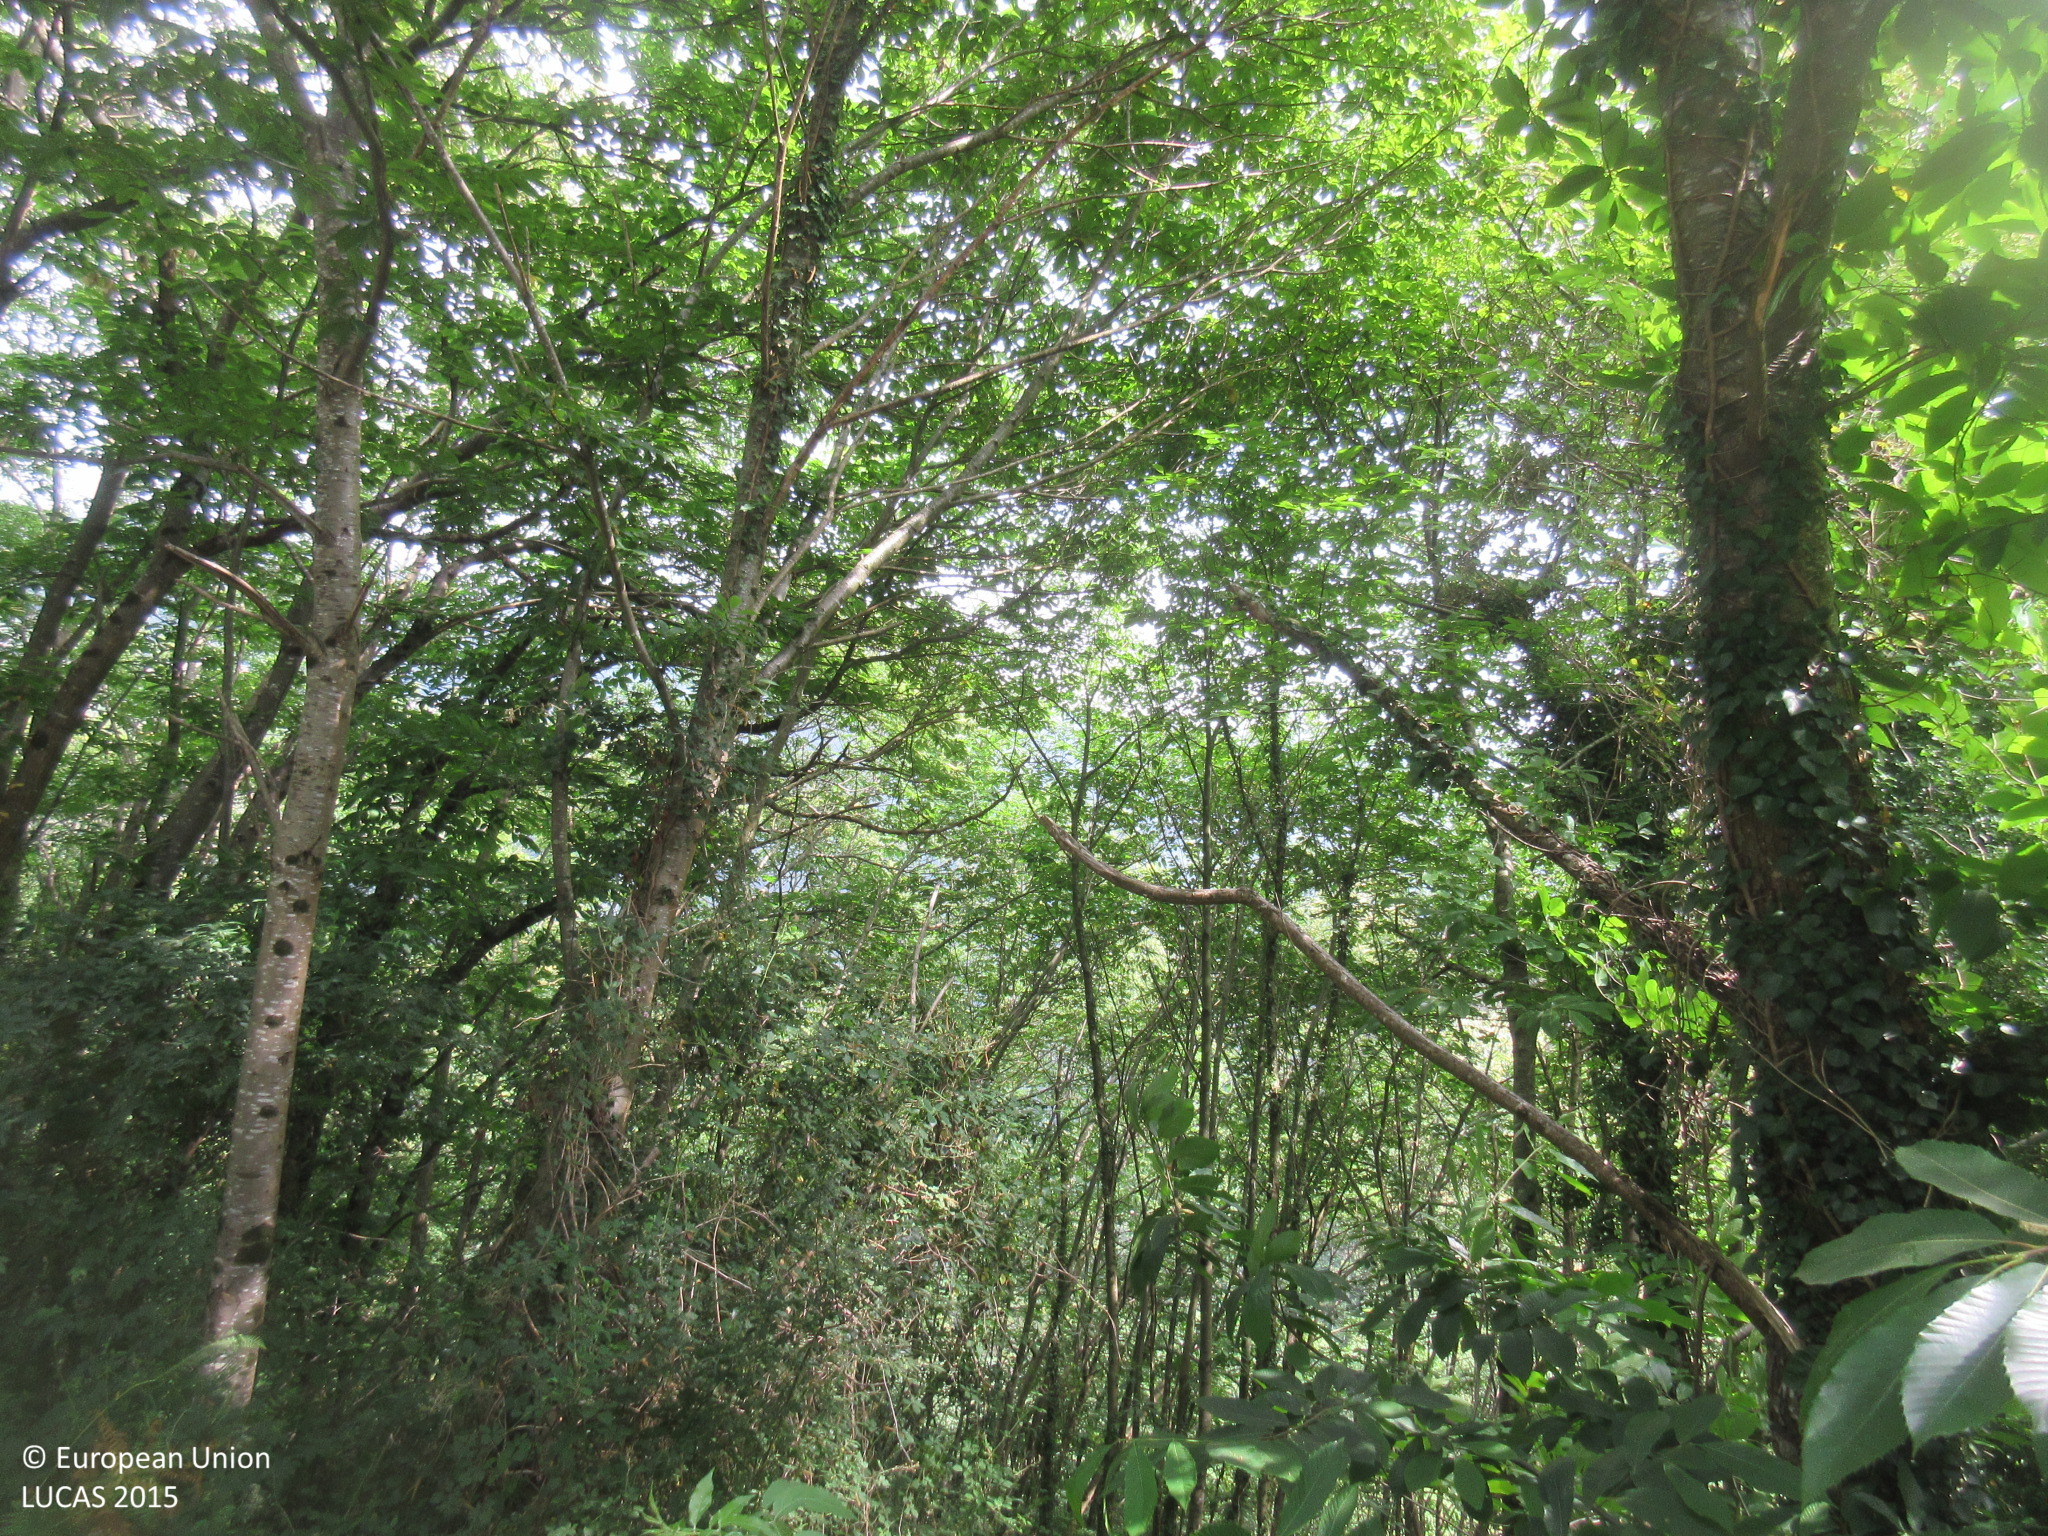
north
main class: Woodland
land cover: Broadleaved woodland
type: thermophilous deciduous forest
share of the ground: > 75 %
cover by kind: broadleaved forest trees 95 %, shrubs 5 %
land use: Forestry
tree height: > 5 m
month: July
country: ES
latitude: 43.4474
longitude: -6.3495
